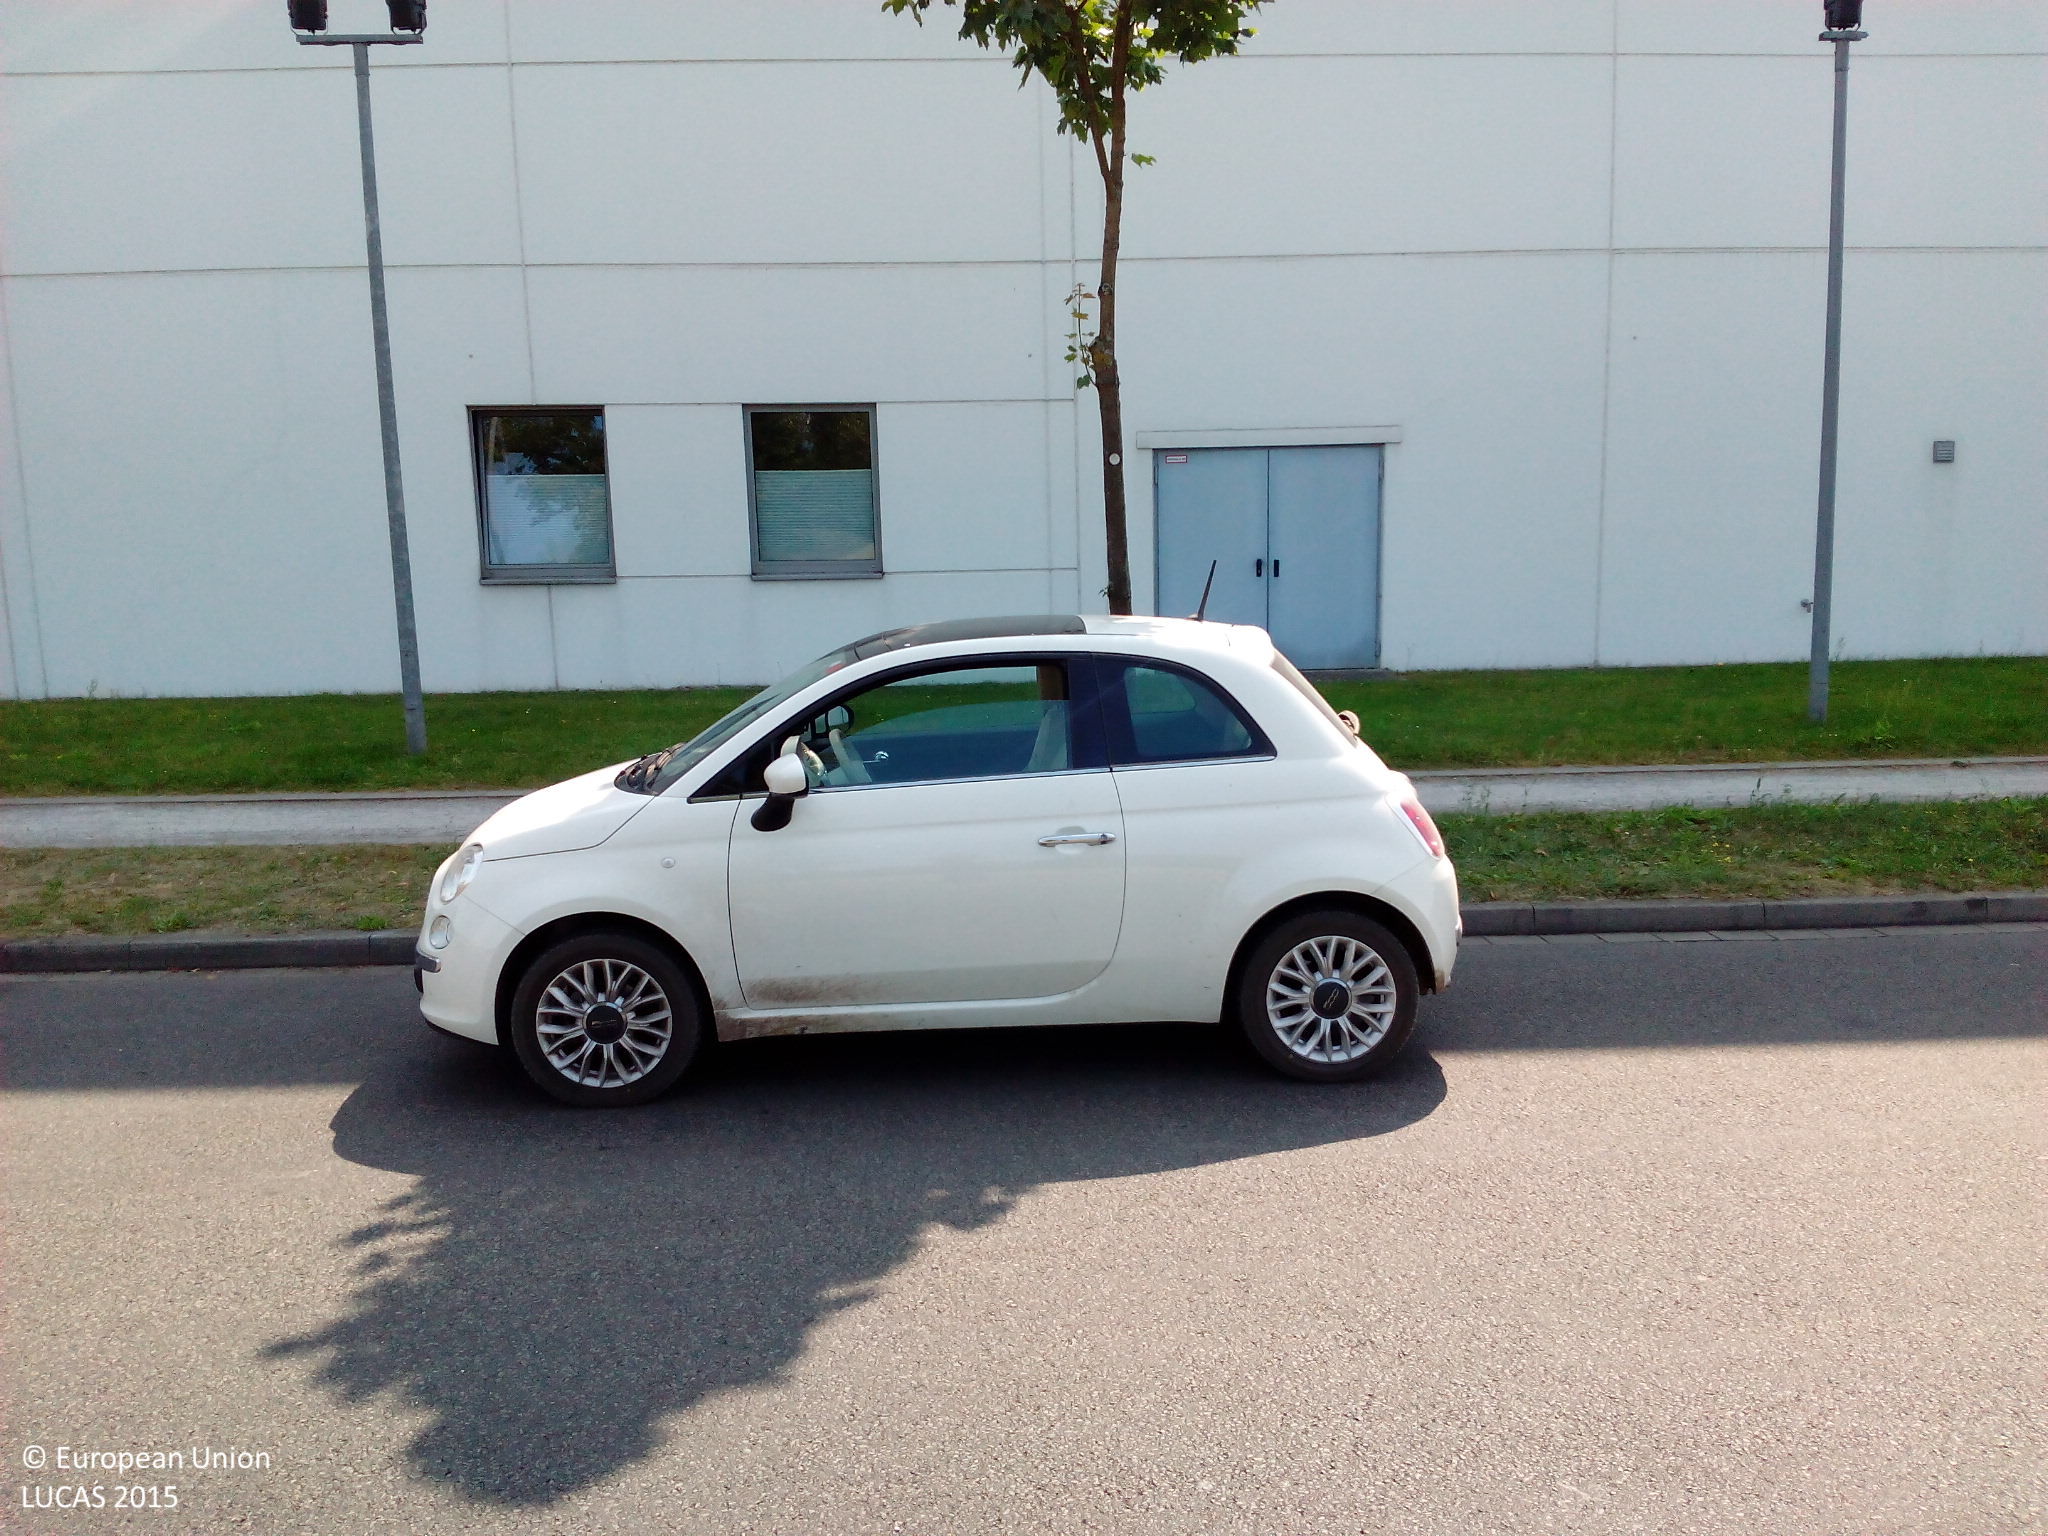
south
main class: Grassland
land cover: Grassland without tree/shrub cover
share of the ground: > 75 %
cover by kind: herbaceous plants 90 %, unconsolidated bare surface 10 %
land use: Machinery and equipment
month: August
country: DE
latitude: 52.6221
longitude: 13.2054
